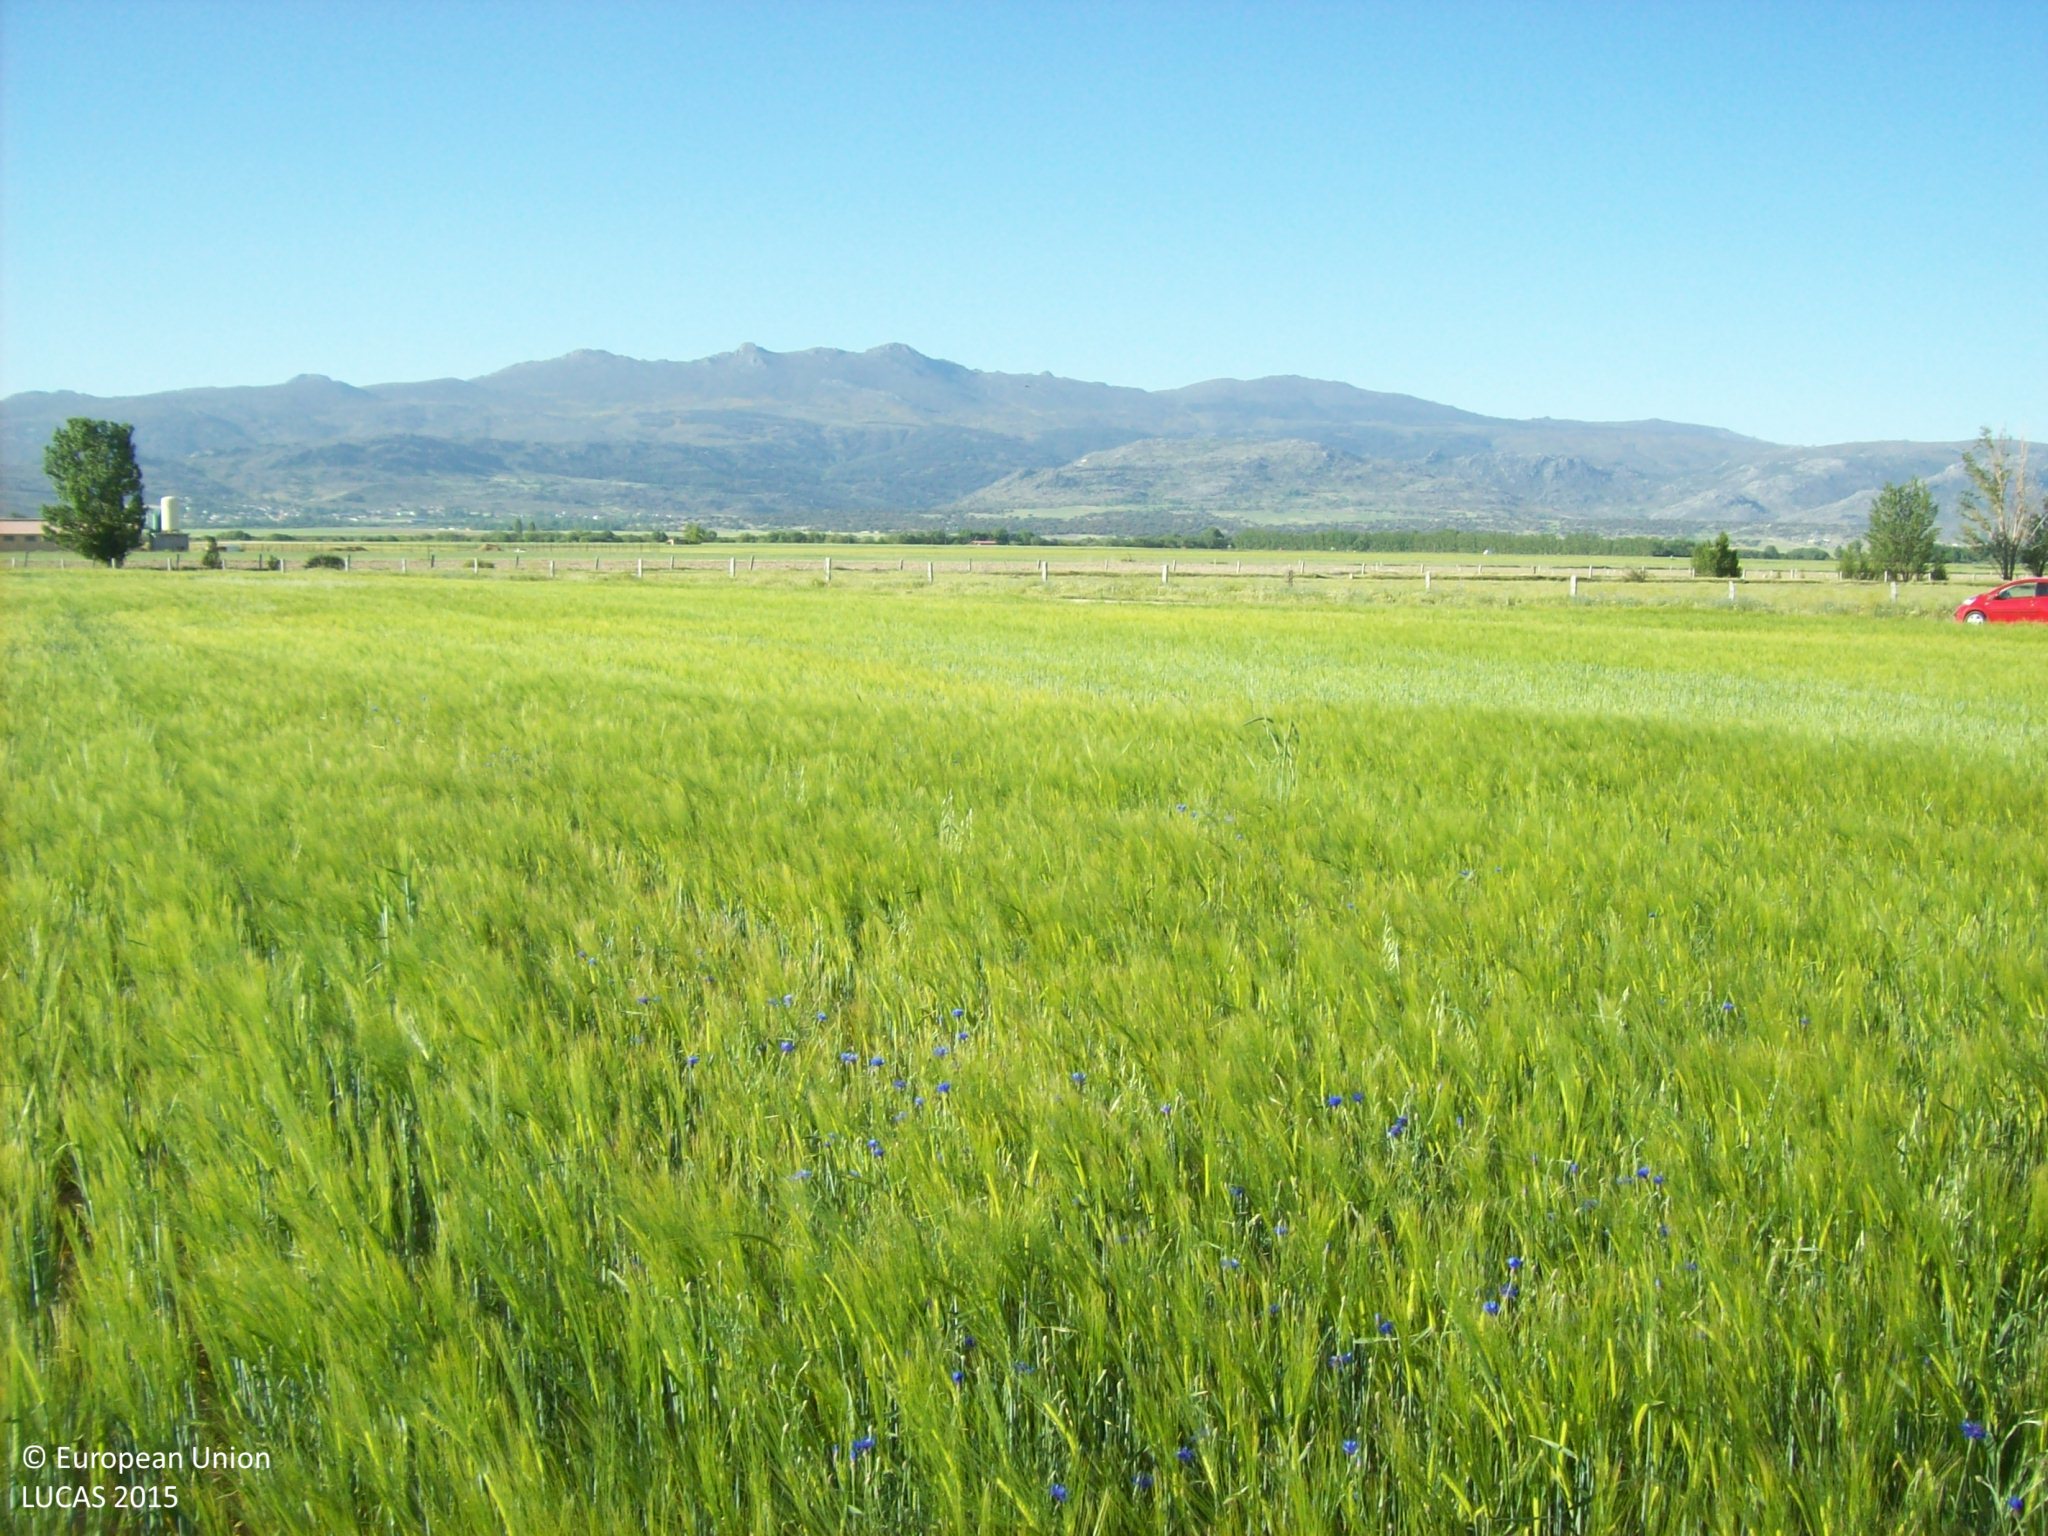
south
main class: Cropland
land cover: Barley
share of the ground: > 75 %
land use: Agriculture (excluding fallow land and kitchen gardens)
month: May
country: ES
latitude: 40.5965
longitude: -4.8638
